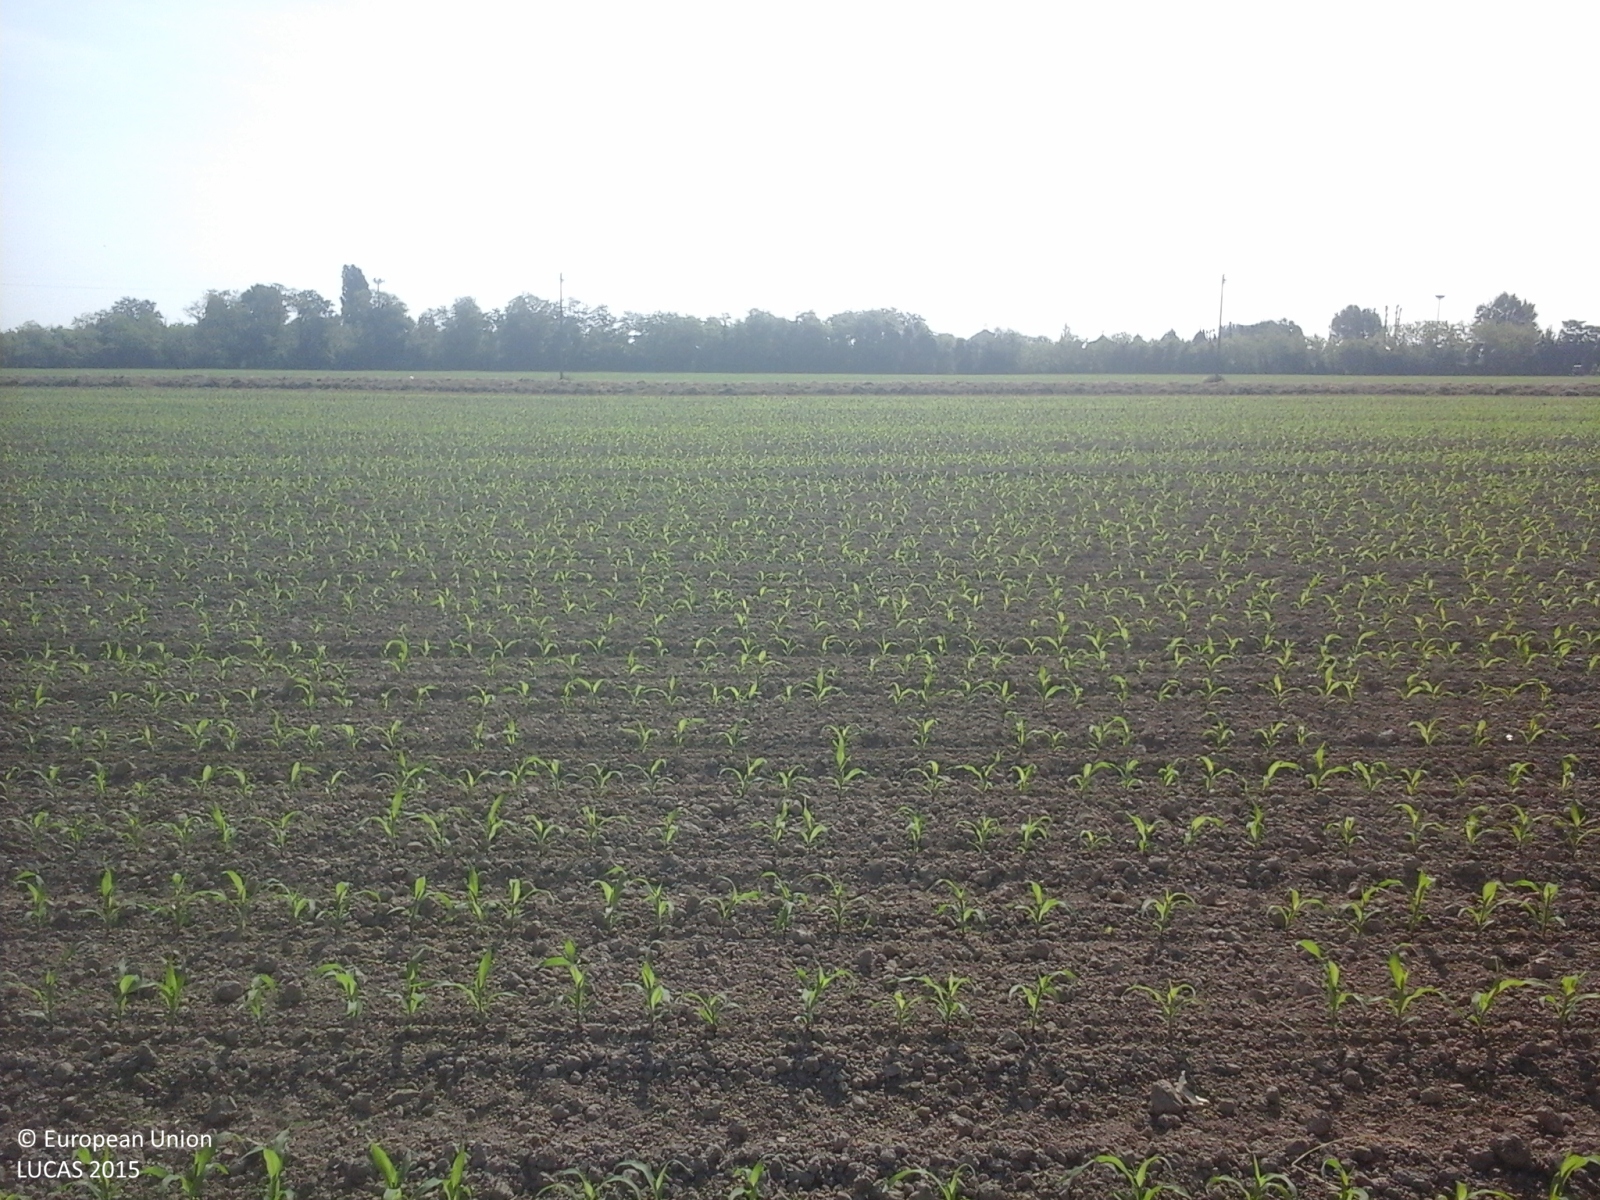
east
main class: Cropland
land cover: Maize
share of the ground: < 10 %
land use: Agriculture (excluding fallow land and kitchen gardens)
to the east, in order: Maize; Lucerne; Tracks; Electric lines; Maize
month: May
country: IT
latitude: 45.0497
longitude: 10.9251
